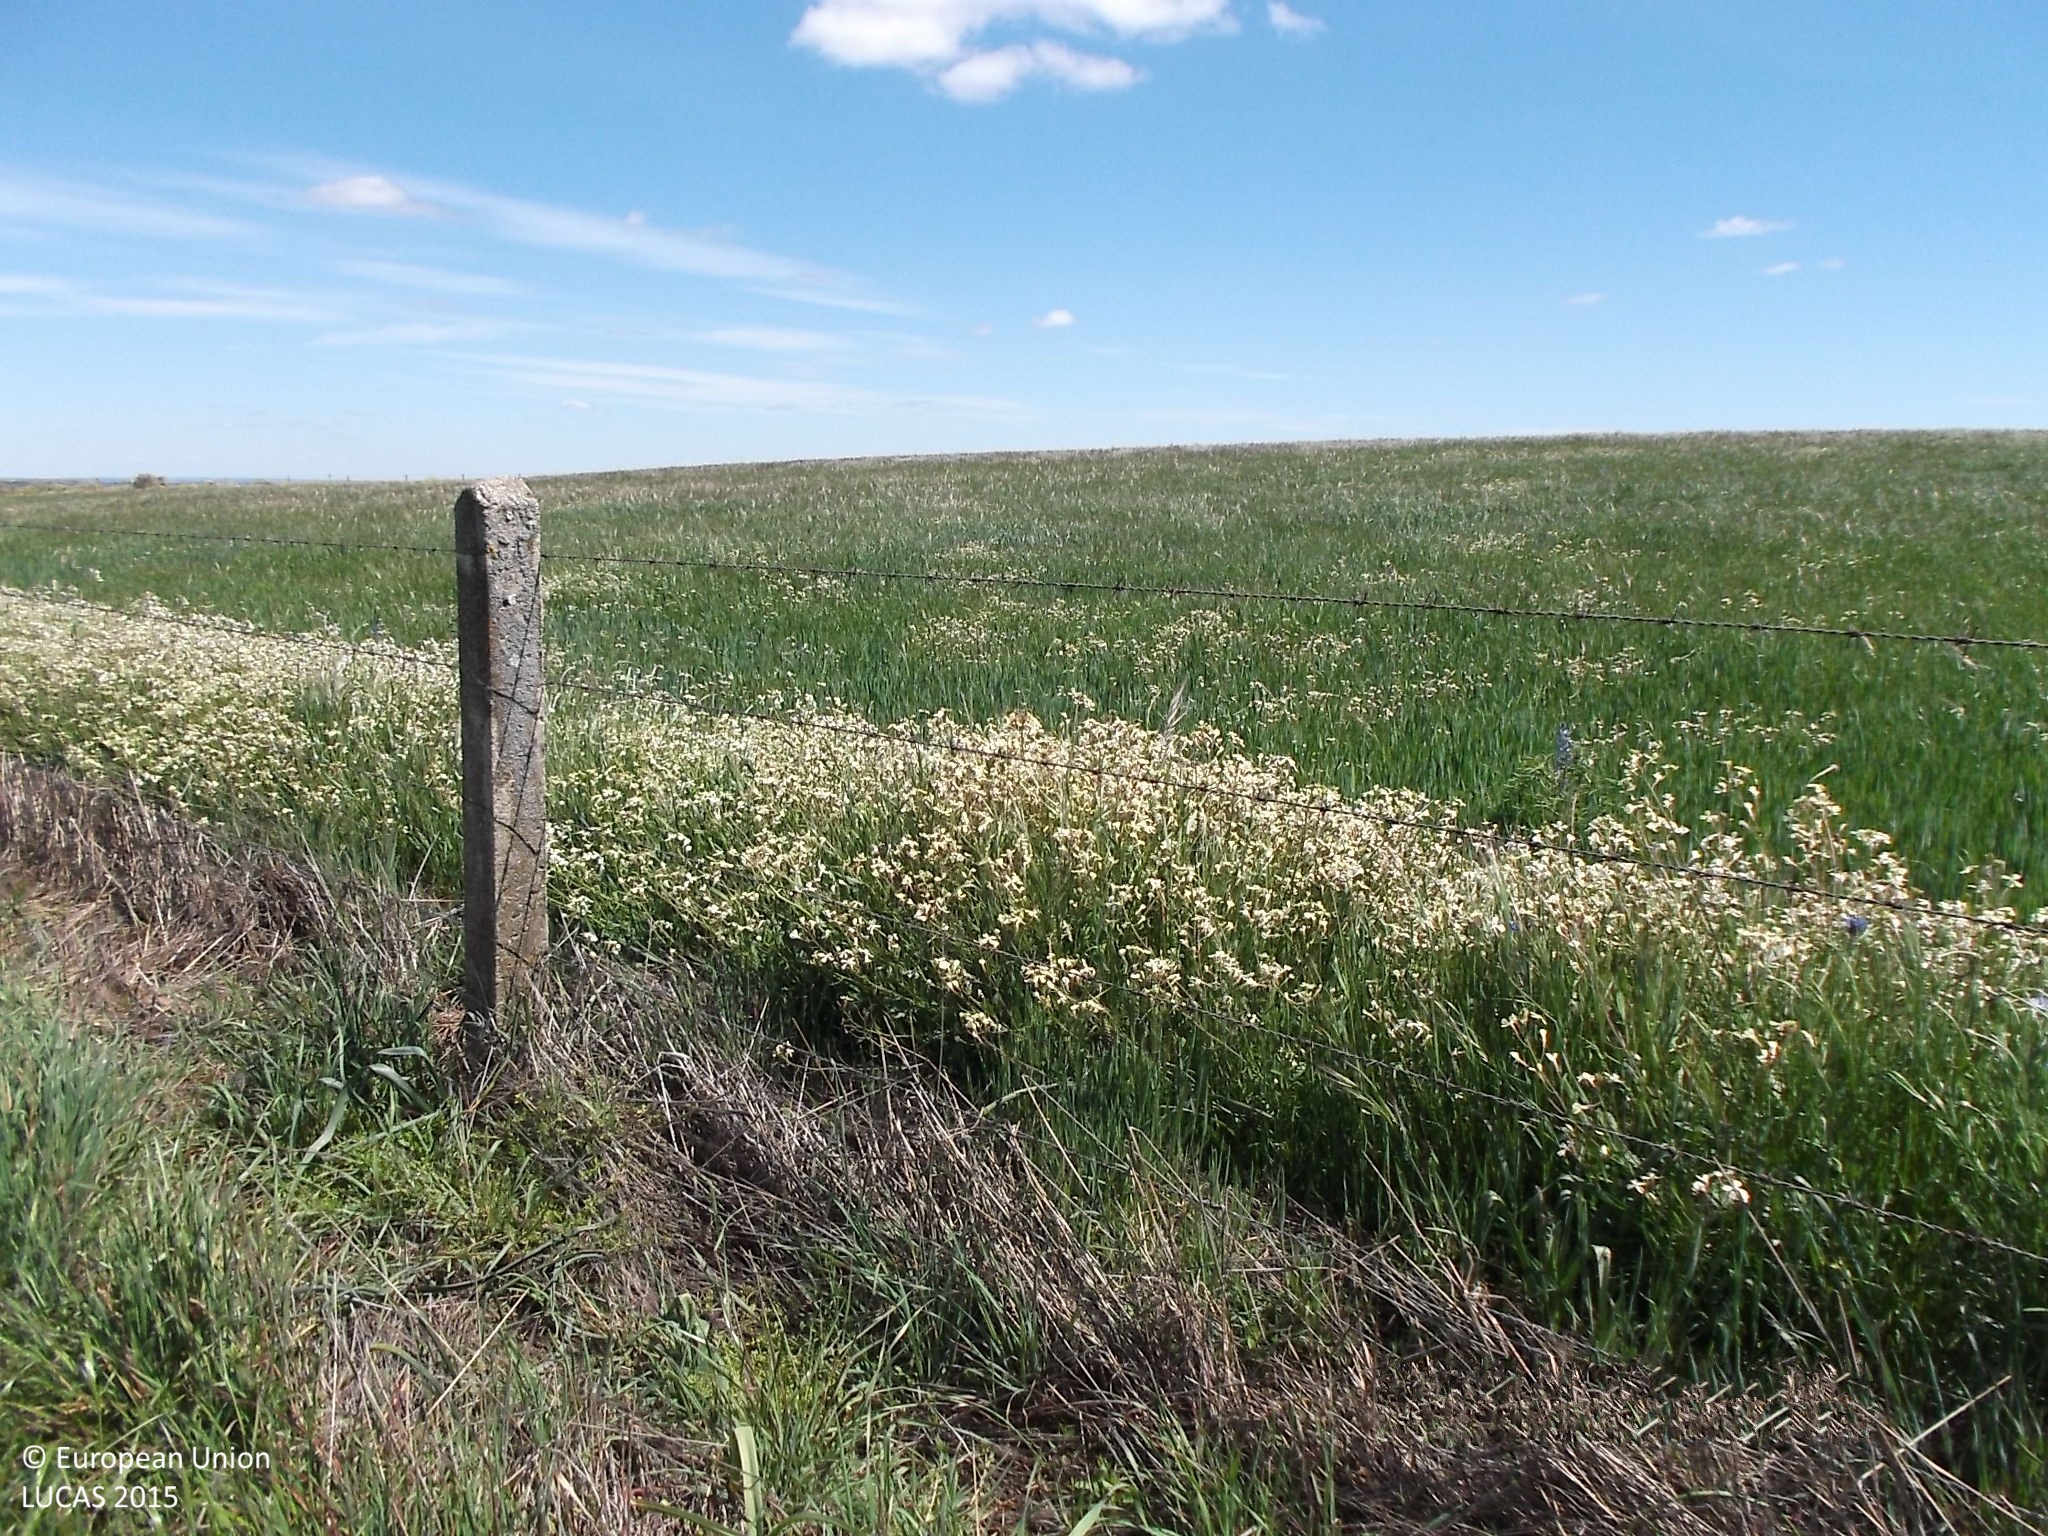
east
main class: Cropland
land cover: Mixed cereals for fodder
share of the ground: > 75 %
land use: Agriculture (excluding fallow land and kitchen gardens)
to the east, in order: Mixed cereals for fodder; Grass margins; Fences; Grass margins; Mixed cereals for fodder; Grass margins; Paved roads, cycling and walking lanes; Grassland without tree/shrub cover; Fences; Grassland without tree/shrub cover
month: April
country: ES
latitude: 41.0256
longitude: -5.9857
